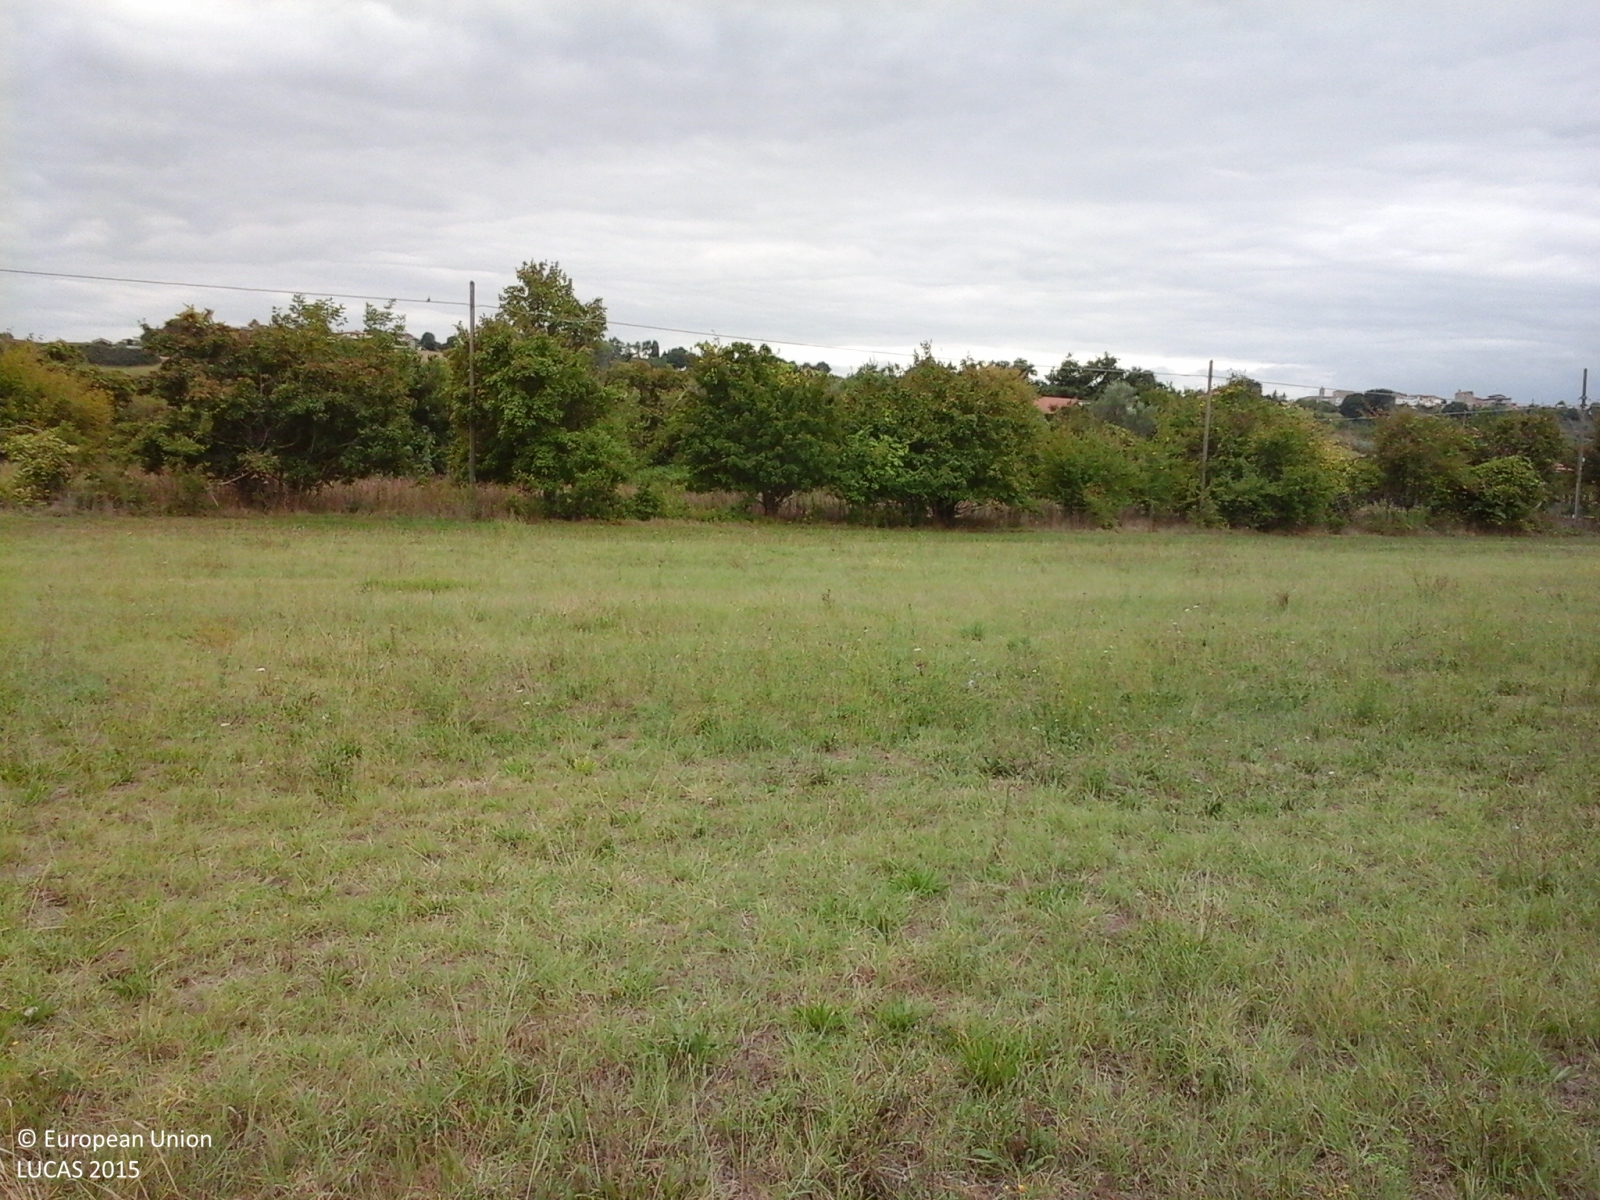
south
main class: Cropland
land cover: Olive groves
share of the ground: < 10 %
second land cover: Spontaneously vegetated surfaces
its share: > 75 %
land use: Agriculture (excluding fallow land and kitchen gardens)
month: September
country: IT
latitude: 42.7991
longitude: 13.8163
